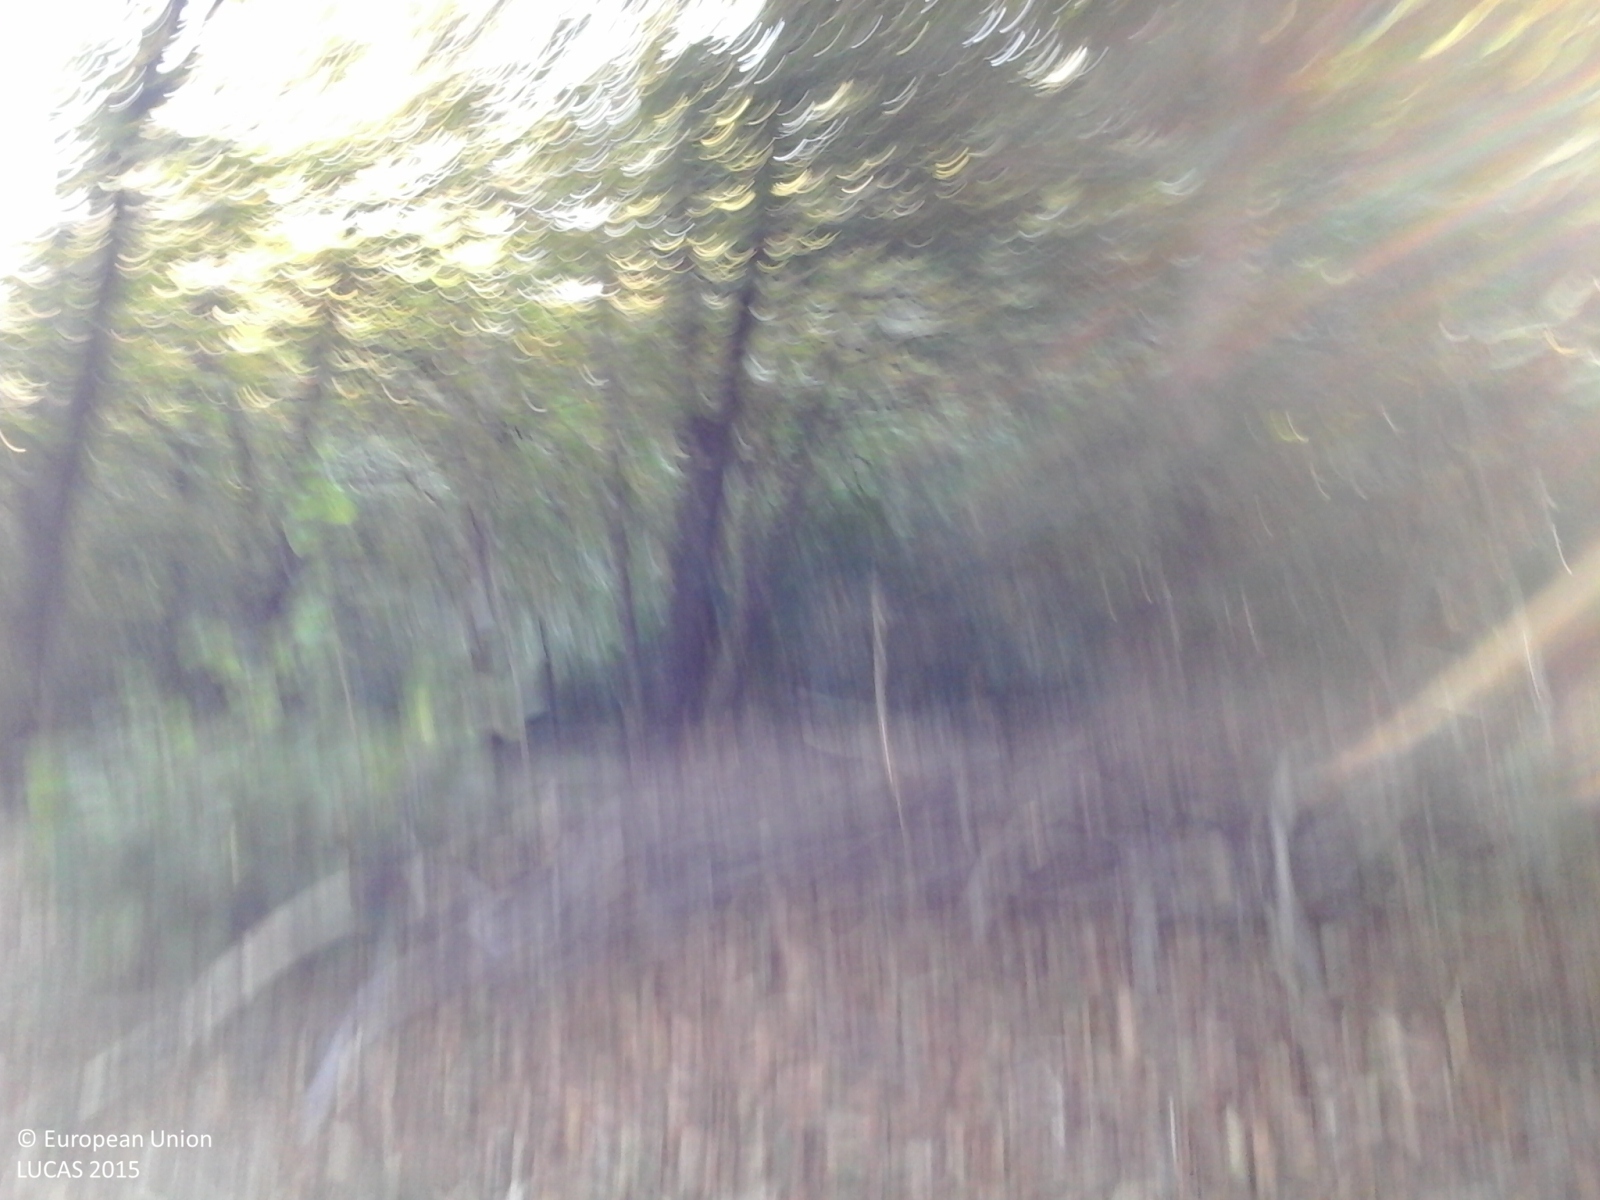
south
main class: Woodland
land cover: Broadleaved woodland
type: beech forest
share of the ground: > 75 %
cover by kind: broadleaved forest trees 100 %
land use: Forestry
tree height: > 5 m
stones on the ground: 25 - 50 %
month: September
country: IT
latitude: 44.4113
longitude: 8.4588
